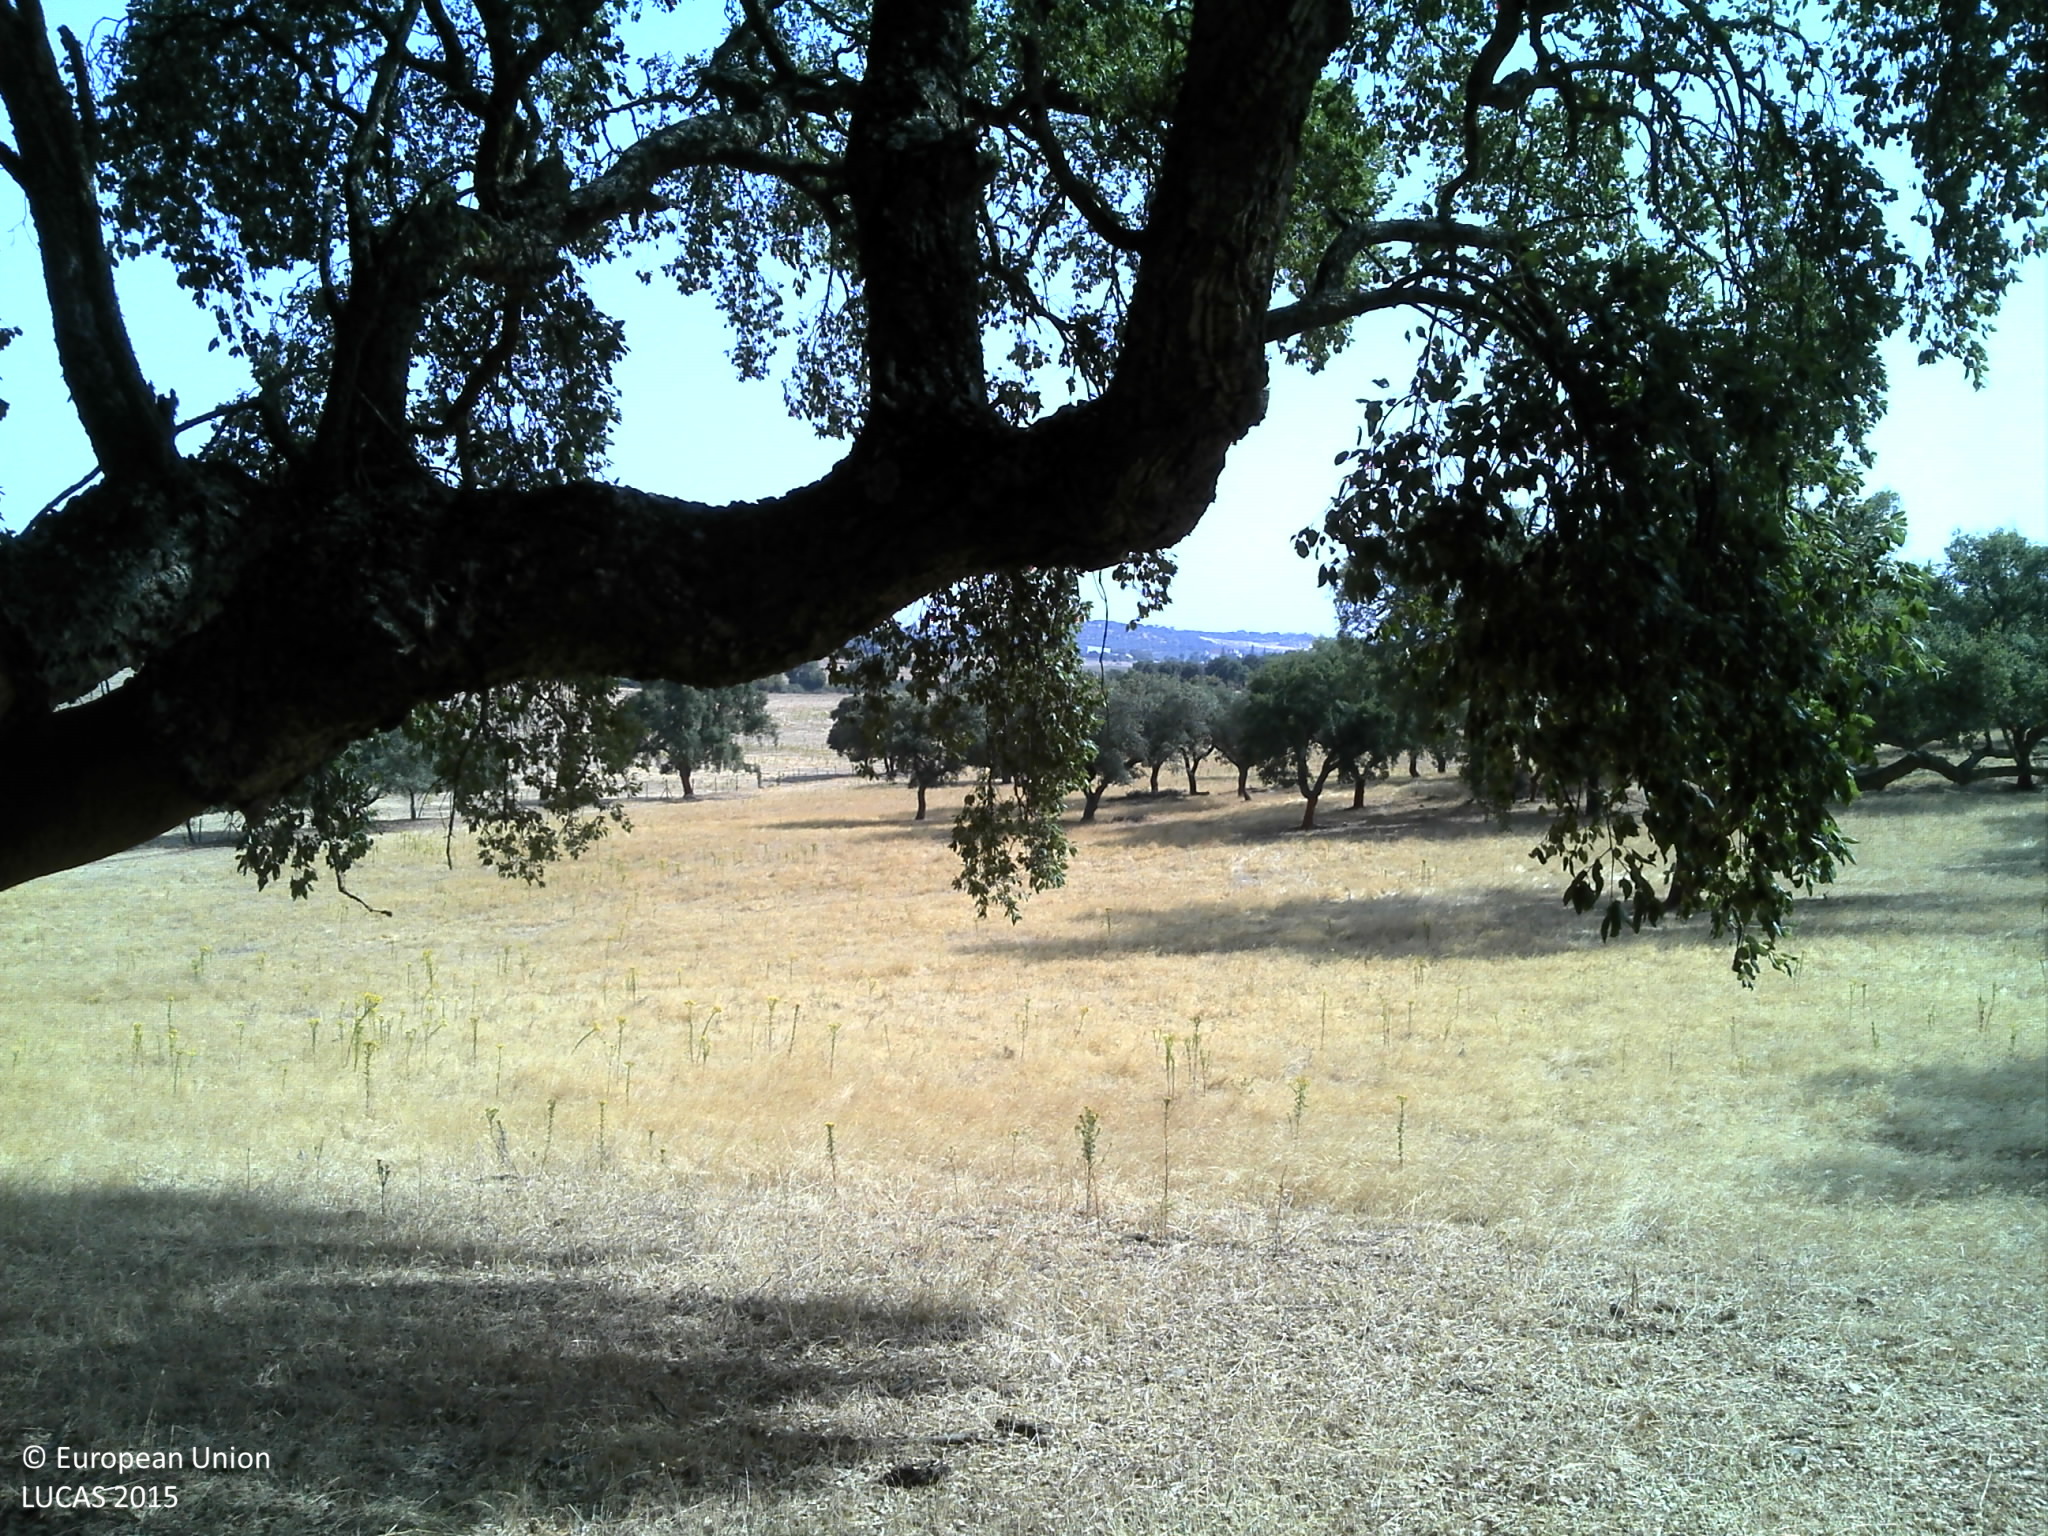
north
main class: Woodland
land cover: Broadleaved woodland
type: broadleaved evergreen forest
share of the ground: 50 - 75 %
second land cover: Grassland without tree/shrub cover
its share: 50 - 75 %
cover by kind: broadleaved forest trees 50 %, herbaceous plants 50 %
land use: Forestry
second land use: Agriculture (excluding fallow land and kitchen gardens)
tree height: > 5 m
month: July
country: PT
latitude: 38.7563
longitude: -7.4897
